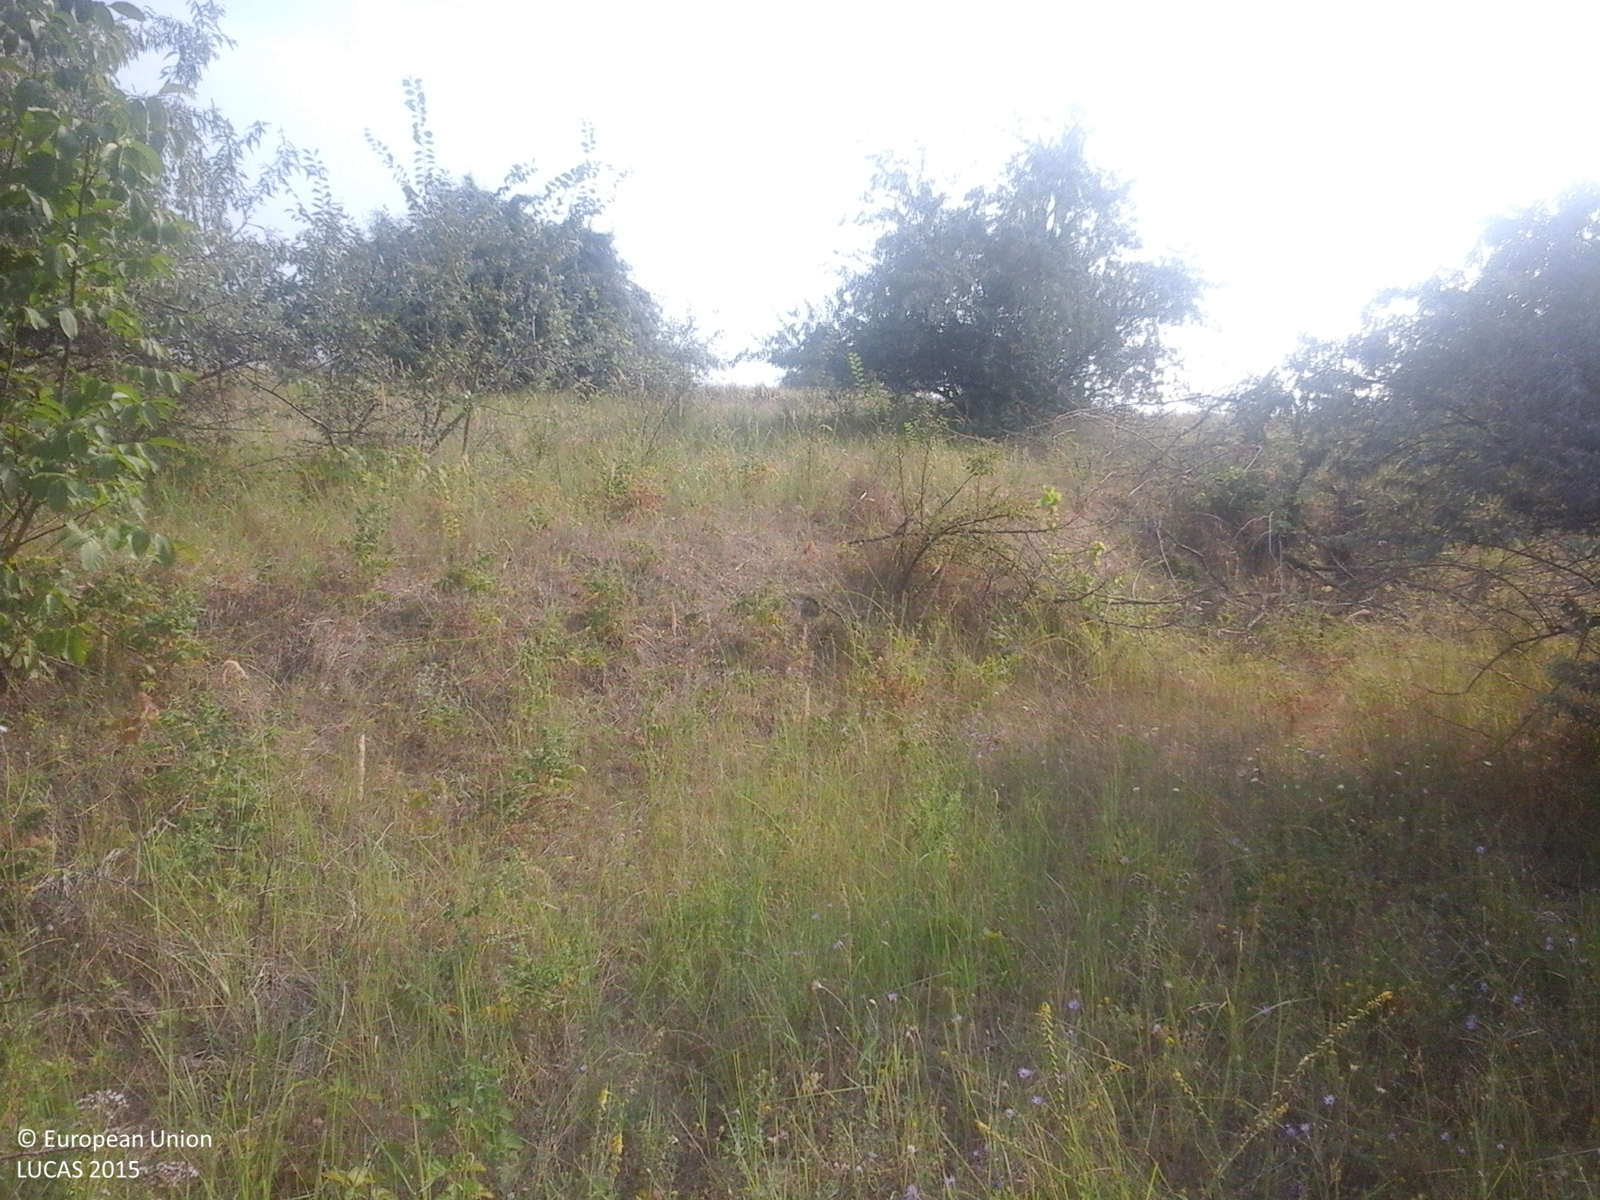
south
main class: Grassland
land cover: Grassland with sparse tree/shrub cover
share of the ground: > 75 %
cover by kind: herbaceous plants 85 %, shrubs 10 %, broadleaved forest trees 5 %
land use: Agriculture (excluding fallow land and kitchen gardens)
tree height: < 5 m
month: July
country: RO
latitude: 45.2647
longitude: 28.3384
